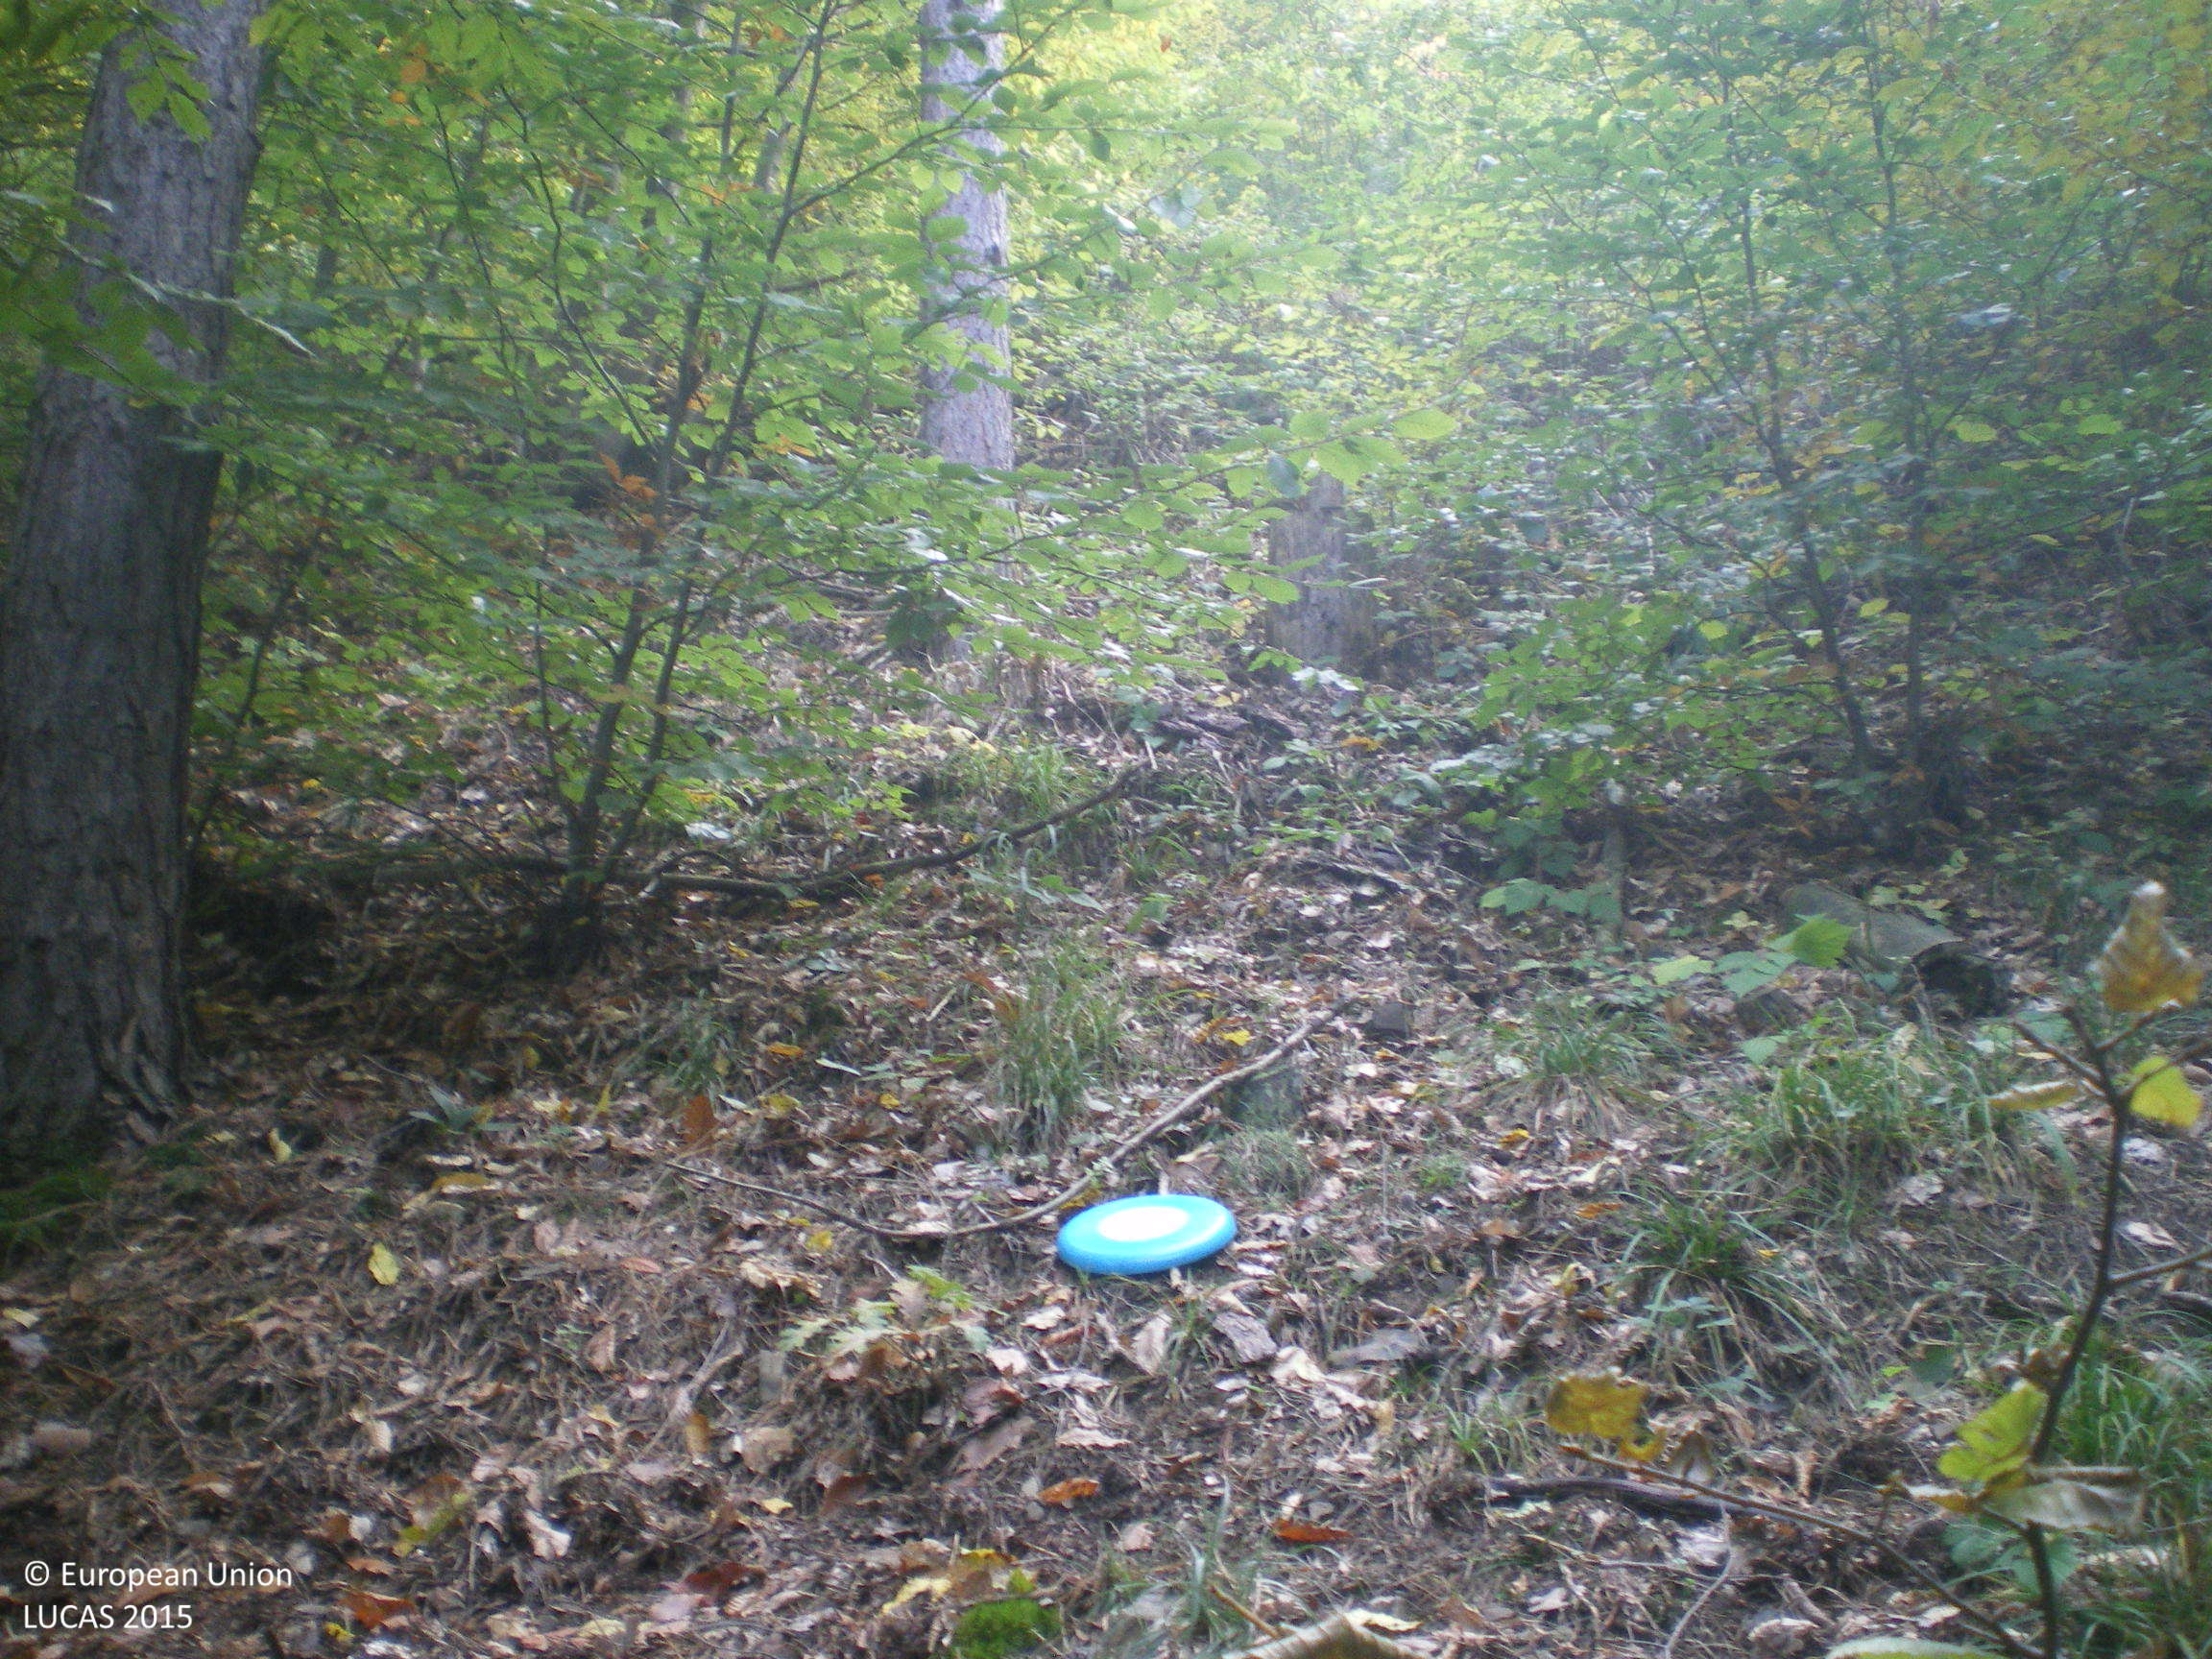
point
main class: Woodland
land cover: Pine dominated mixed woodland
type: hemiboreal forest and nemoral coniferous forest and mixed broadleaved-coniferous forest
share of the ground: > 75 %
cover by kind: coniferous forest trees 60 %, broadleaved forest trees 25 %, shrubs 15 %
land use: Forestry
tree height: > 5 m
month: October
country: BG
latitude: 42.7287
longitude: 25.6726
